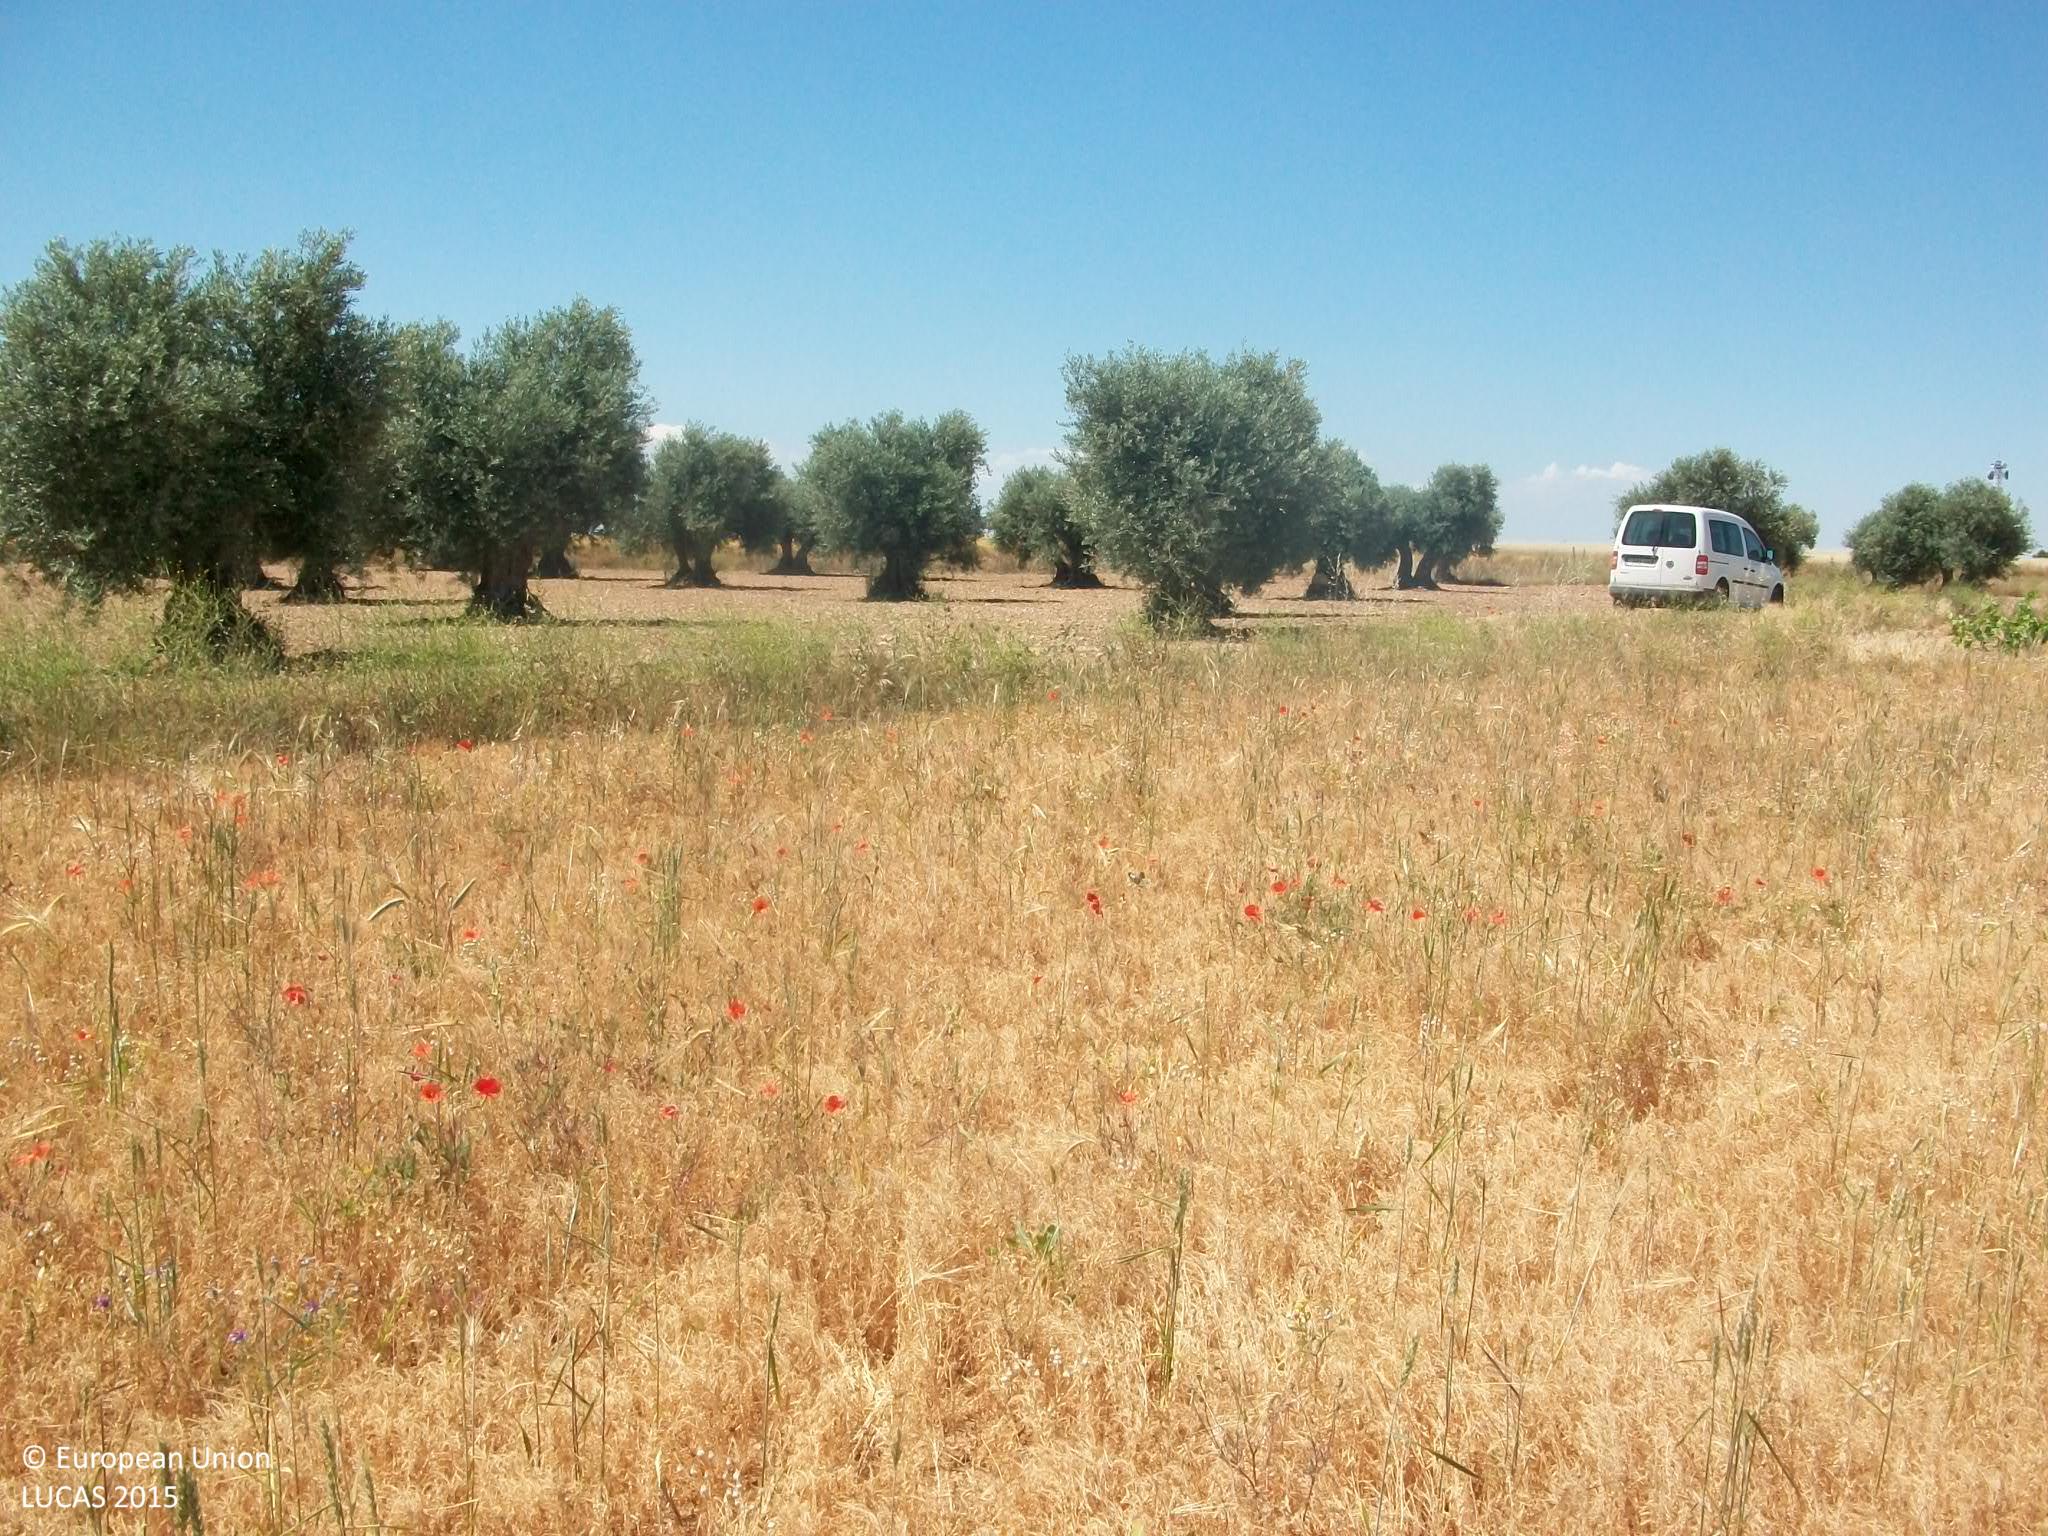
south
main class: Cropland
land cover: Common wheat
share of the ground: > 75 %
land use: Agriculture (excluding fallow land and kitchen gardens)
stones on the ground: > 50 %
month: May
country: ES
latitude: 39.9004
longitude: -3.6089
